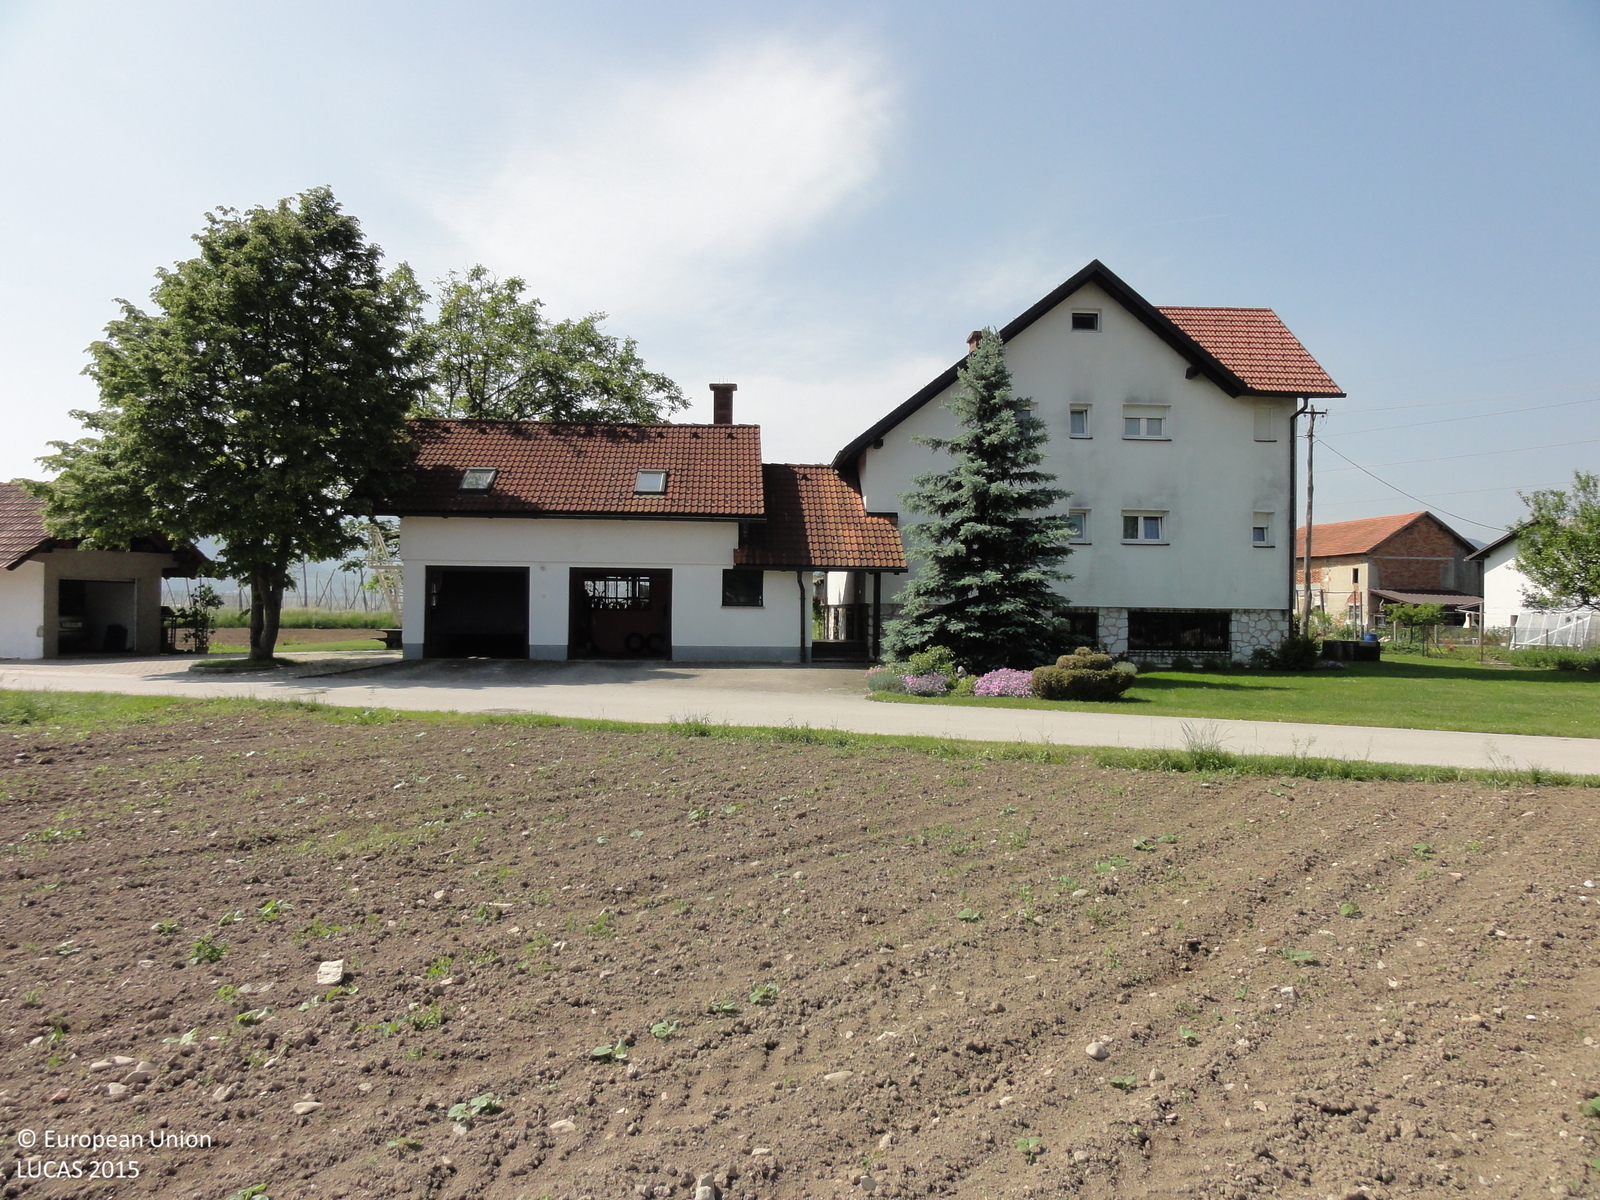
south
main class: Cropland
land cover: Other fresh vegetables
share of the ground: < 10 %
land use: Agriculture (excluding fallow land and kitchen gardens)
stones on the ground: 10 - 25 %
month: May
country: SI
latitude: 46.2634
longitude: 15.1483
